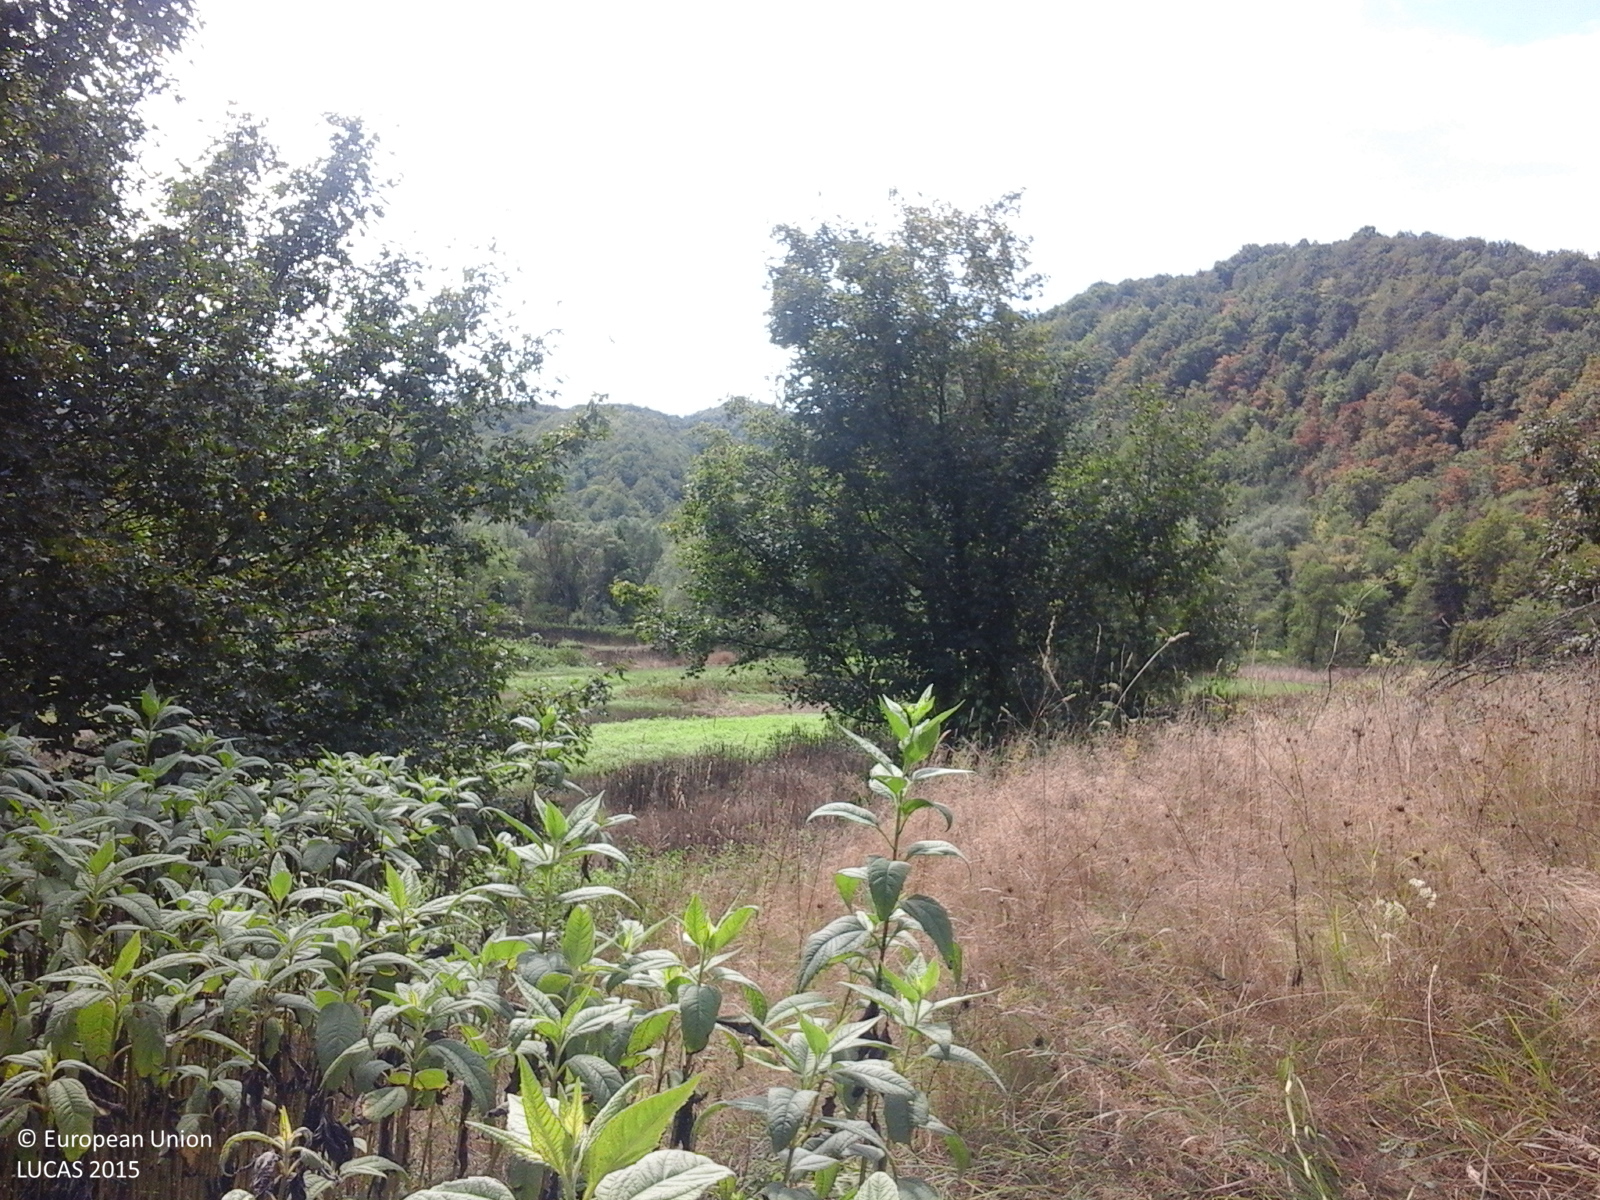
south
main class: Grassland
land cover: Spontaneously vegetated surfaces
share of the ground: > 75 %
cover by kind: herbaceous plants 100 %
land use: Fallow land
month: August
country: RO
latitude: 44.8334
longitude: 21.8594
